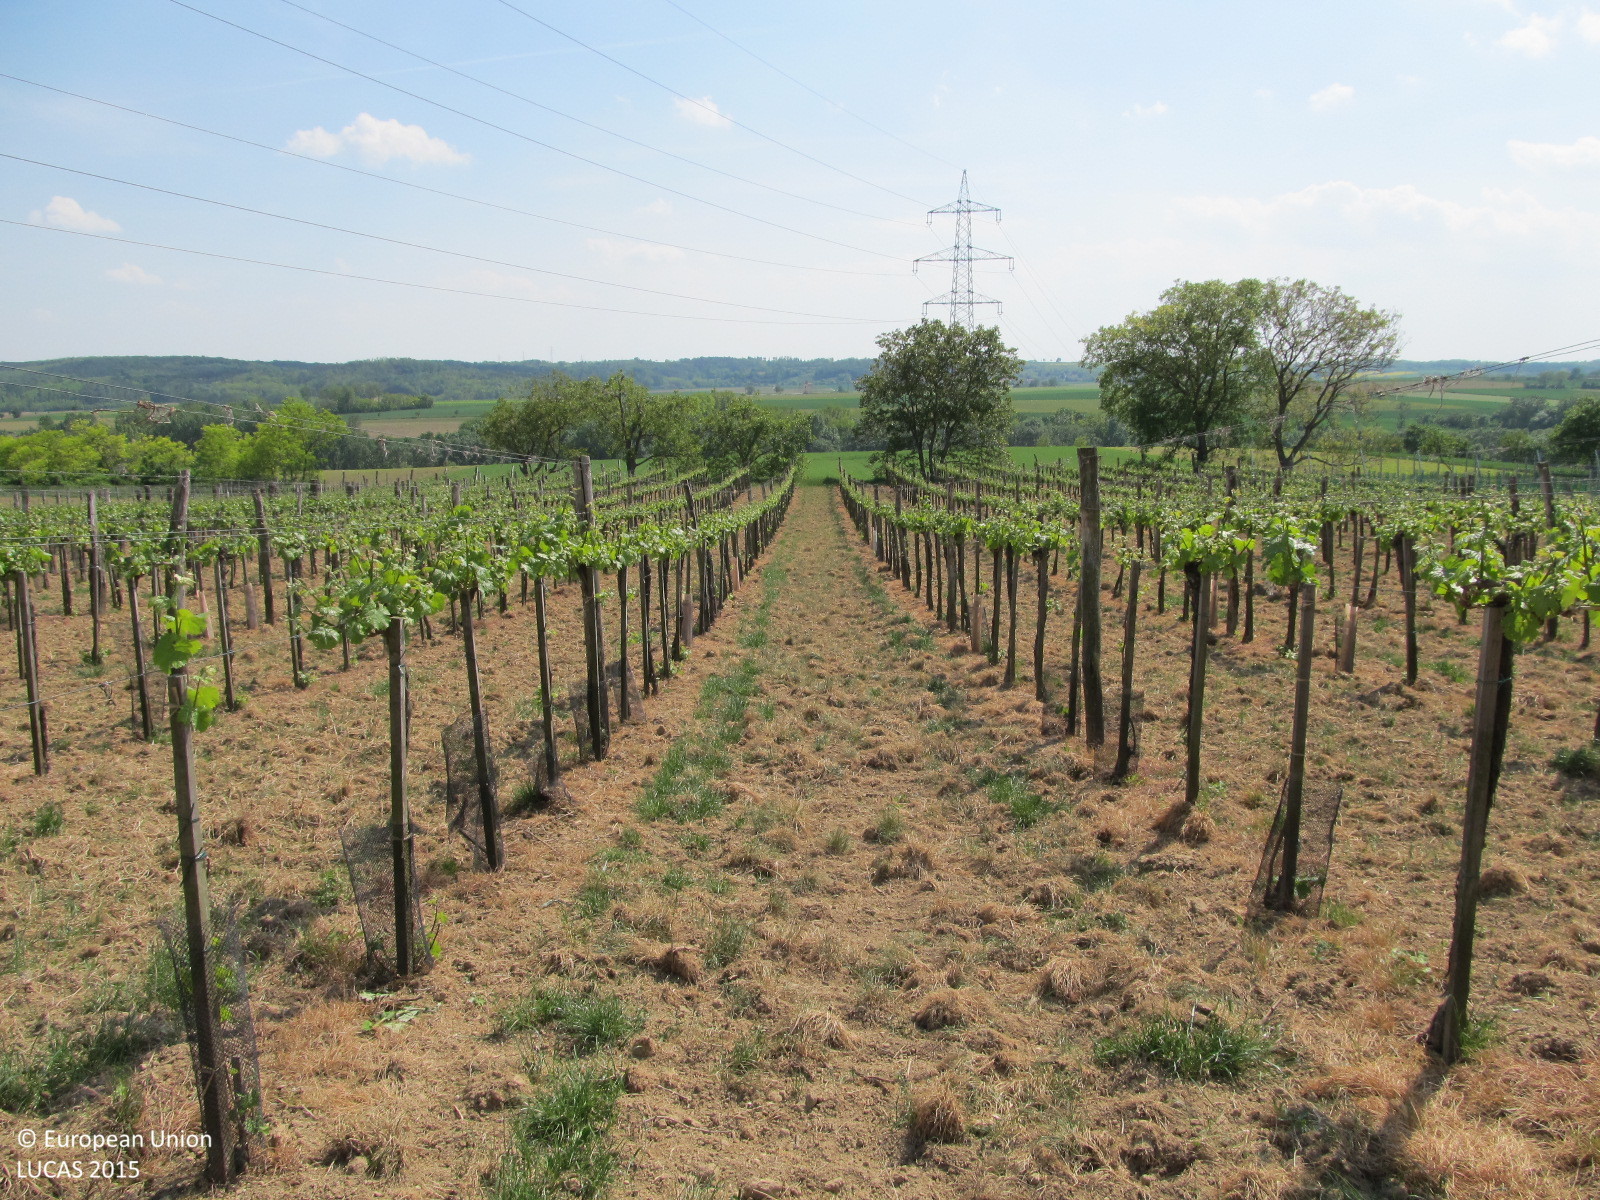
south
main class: Cropland
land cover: Vineyards
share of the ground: 25 - 50 %
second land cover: Spontaneously vegetated surfaces
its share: 50 - 75 %
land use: Agriculture (excluding fallow land and kitchen gardens)
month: May
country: AT
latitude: 48.5363
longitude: 15.8681
